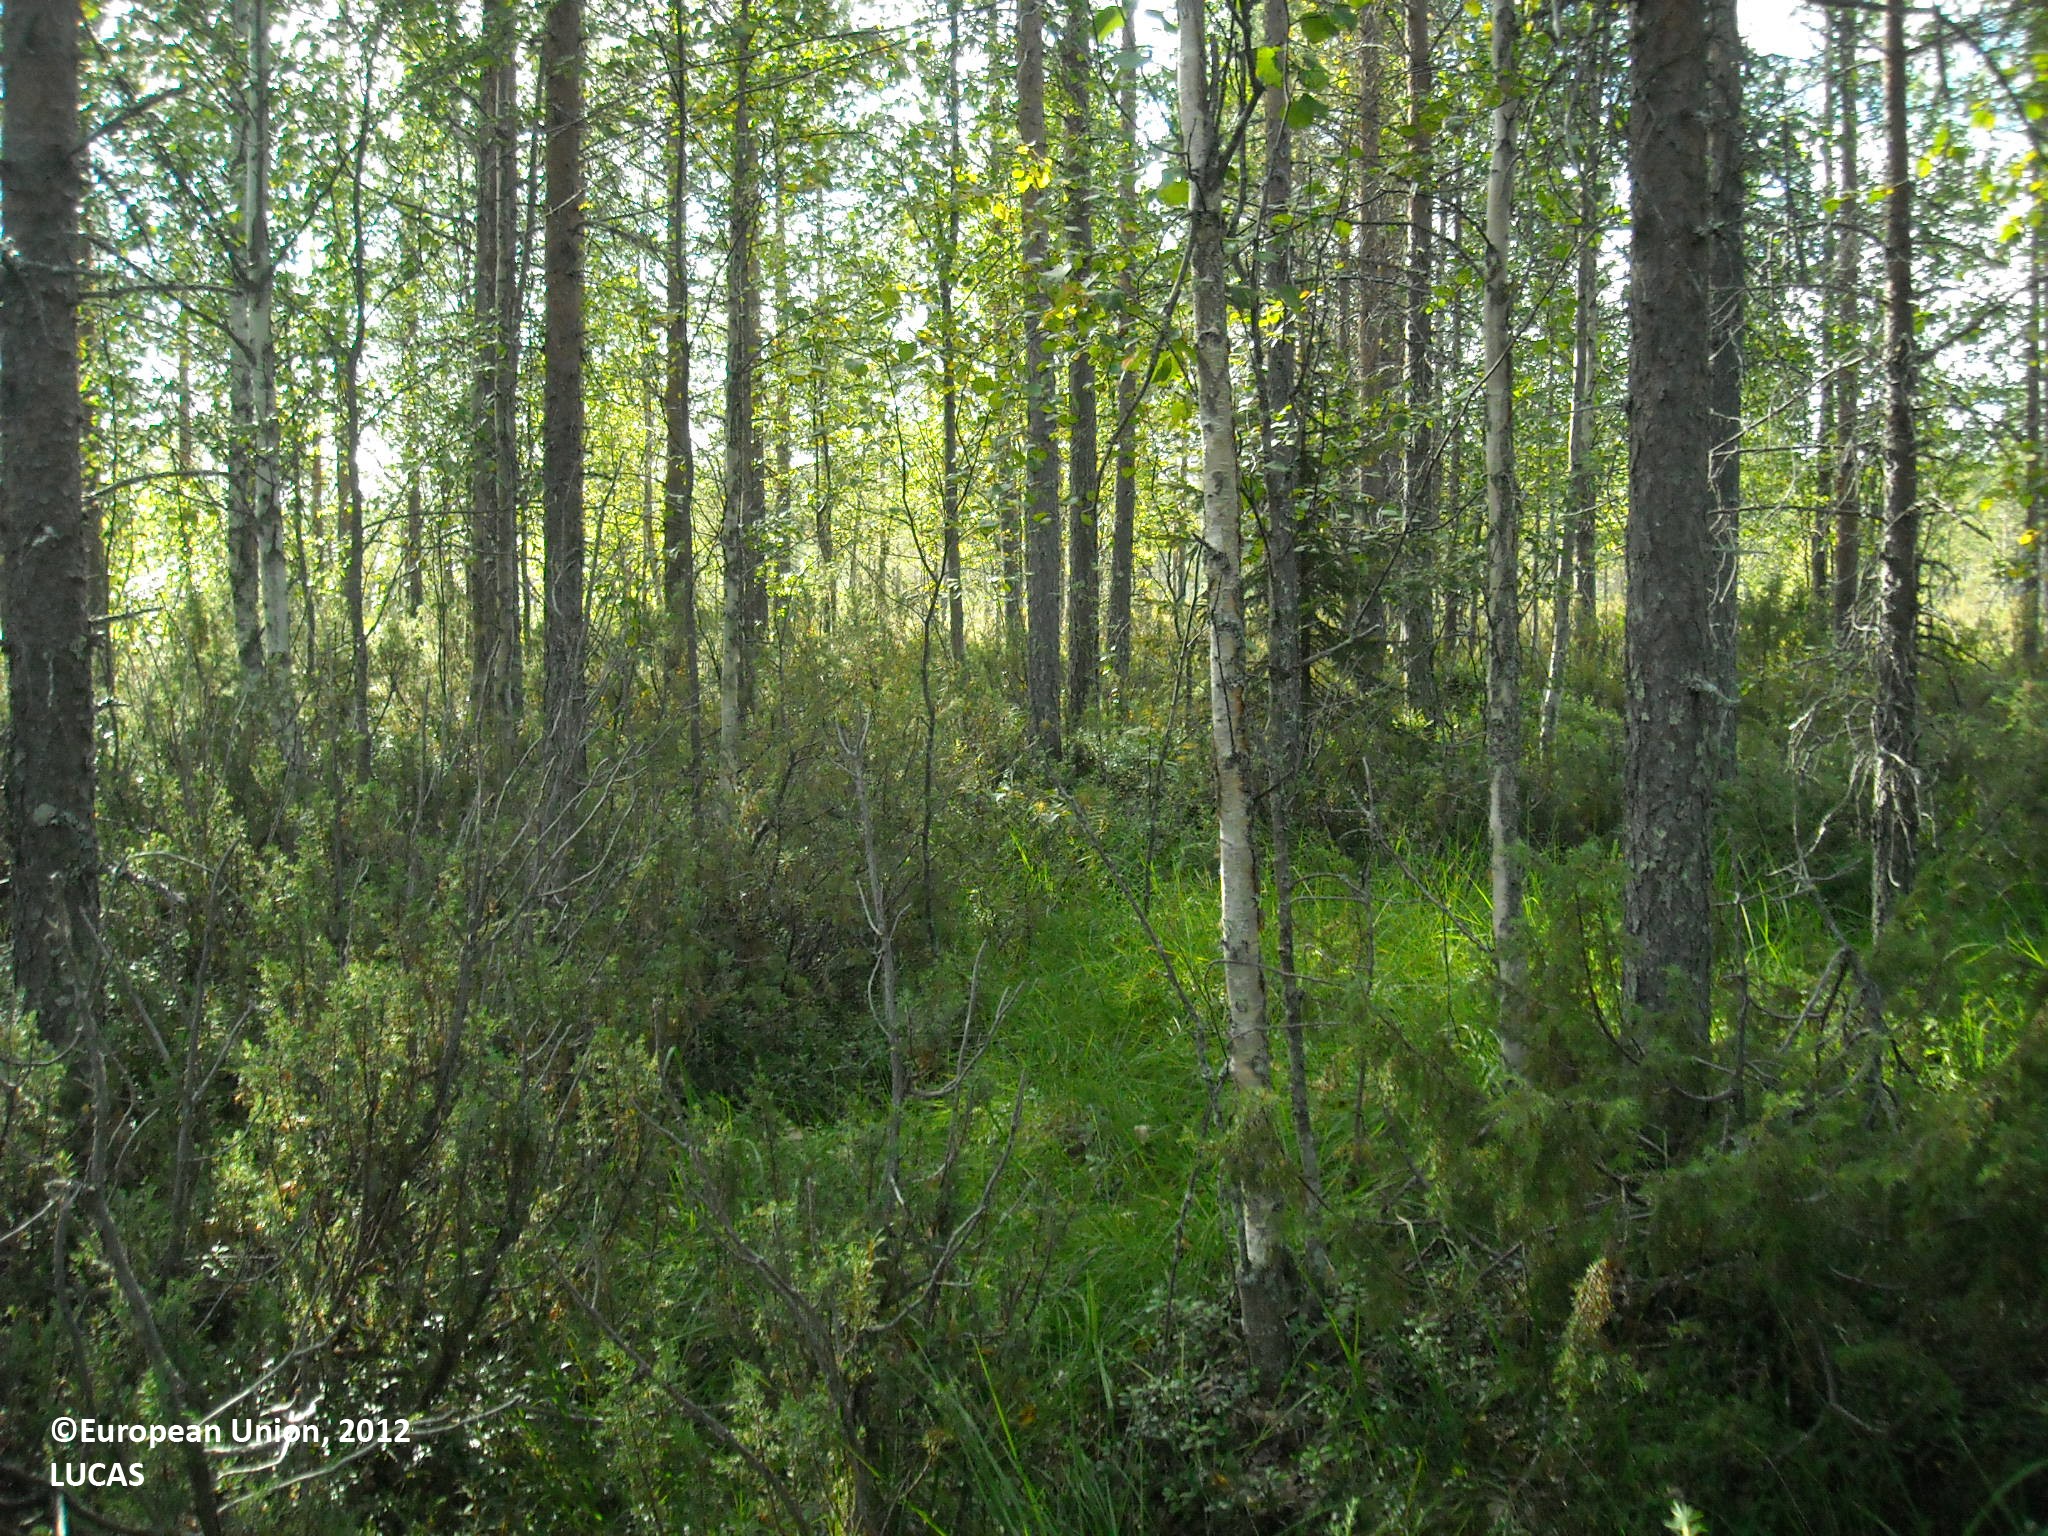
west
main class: Woodland
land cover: Pine dominated mixed woodland
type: boreal forest
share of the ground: > 75 %
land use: Forestry
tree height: > 5 m
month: August
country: FI
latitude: 65.3824
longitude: 27.7149
